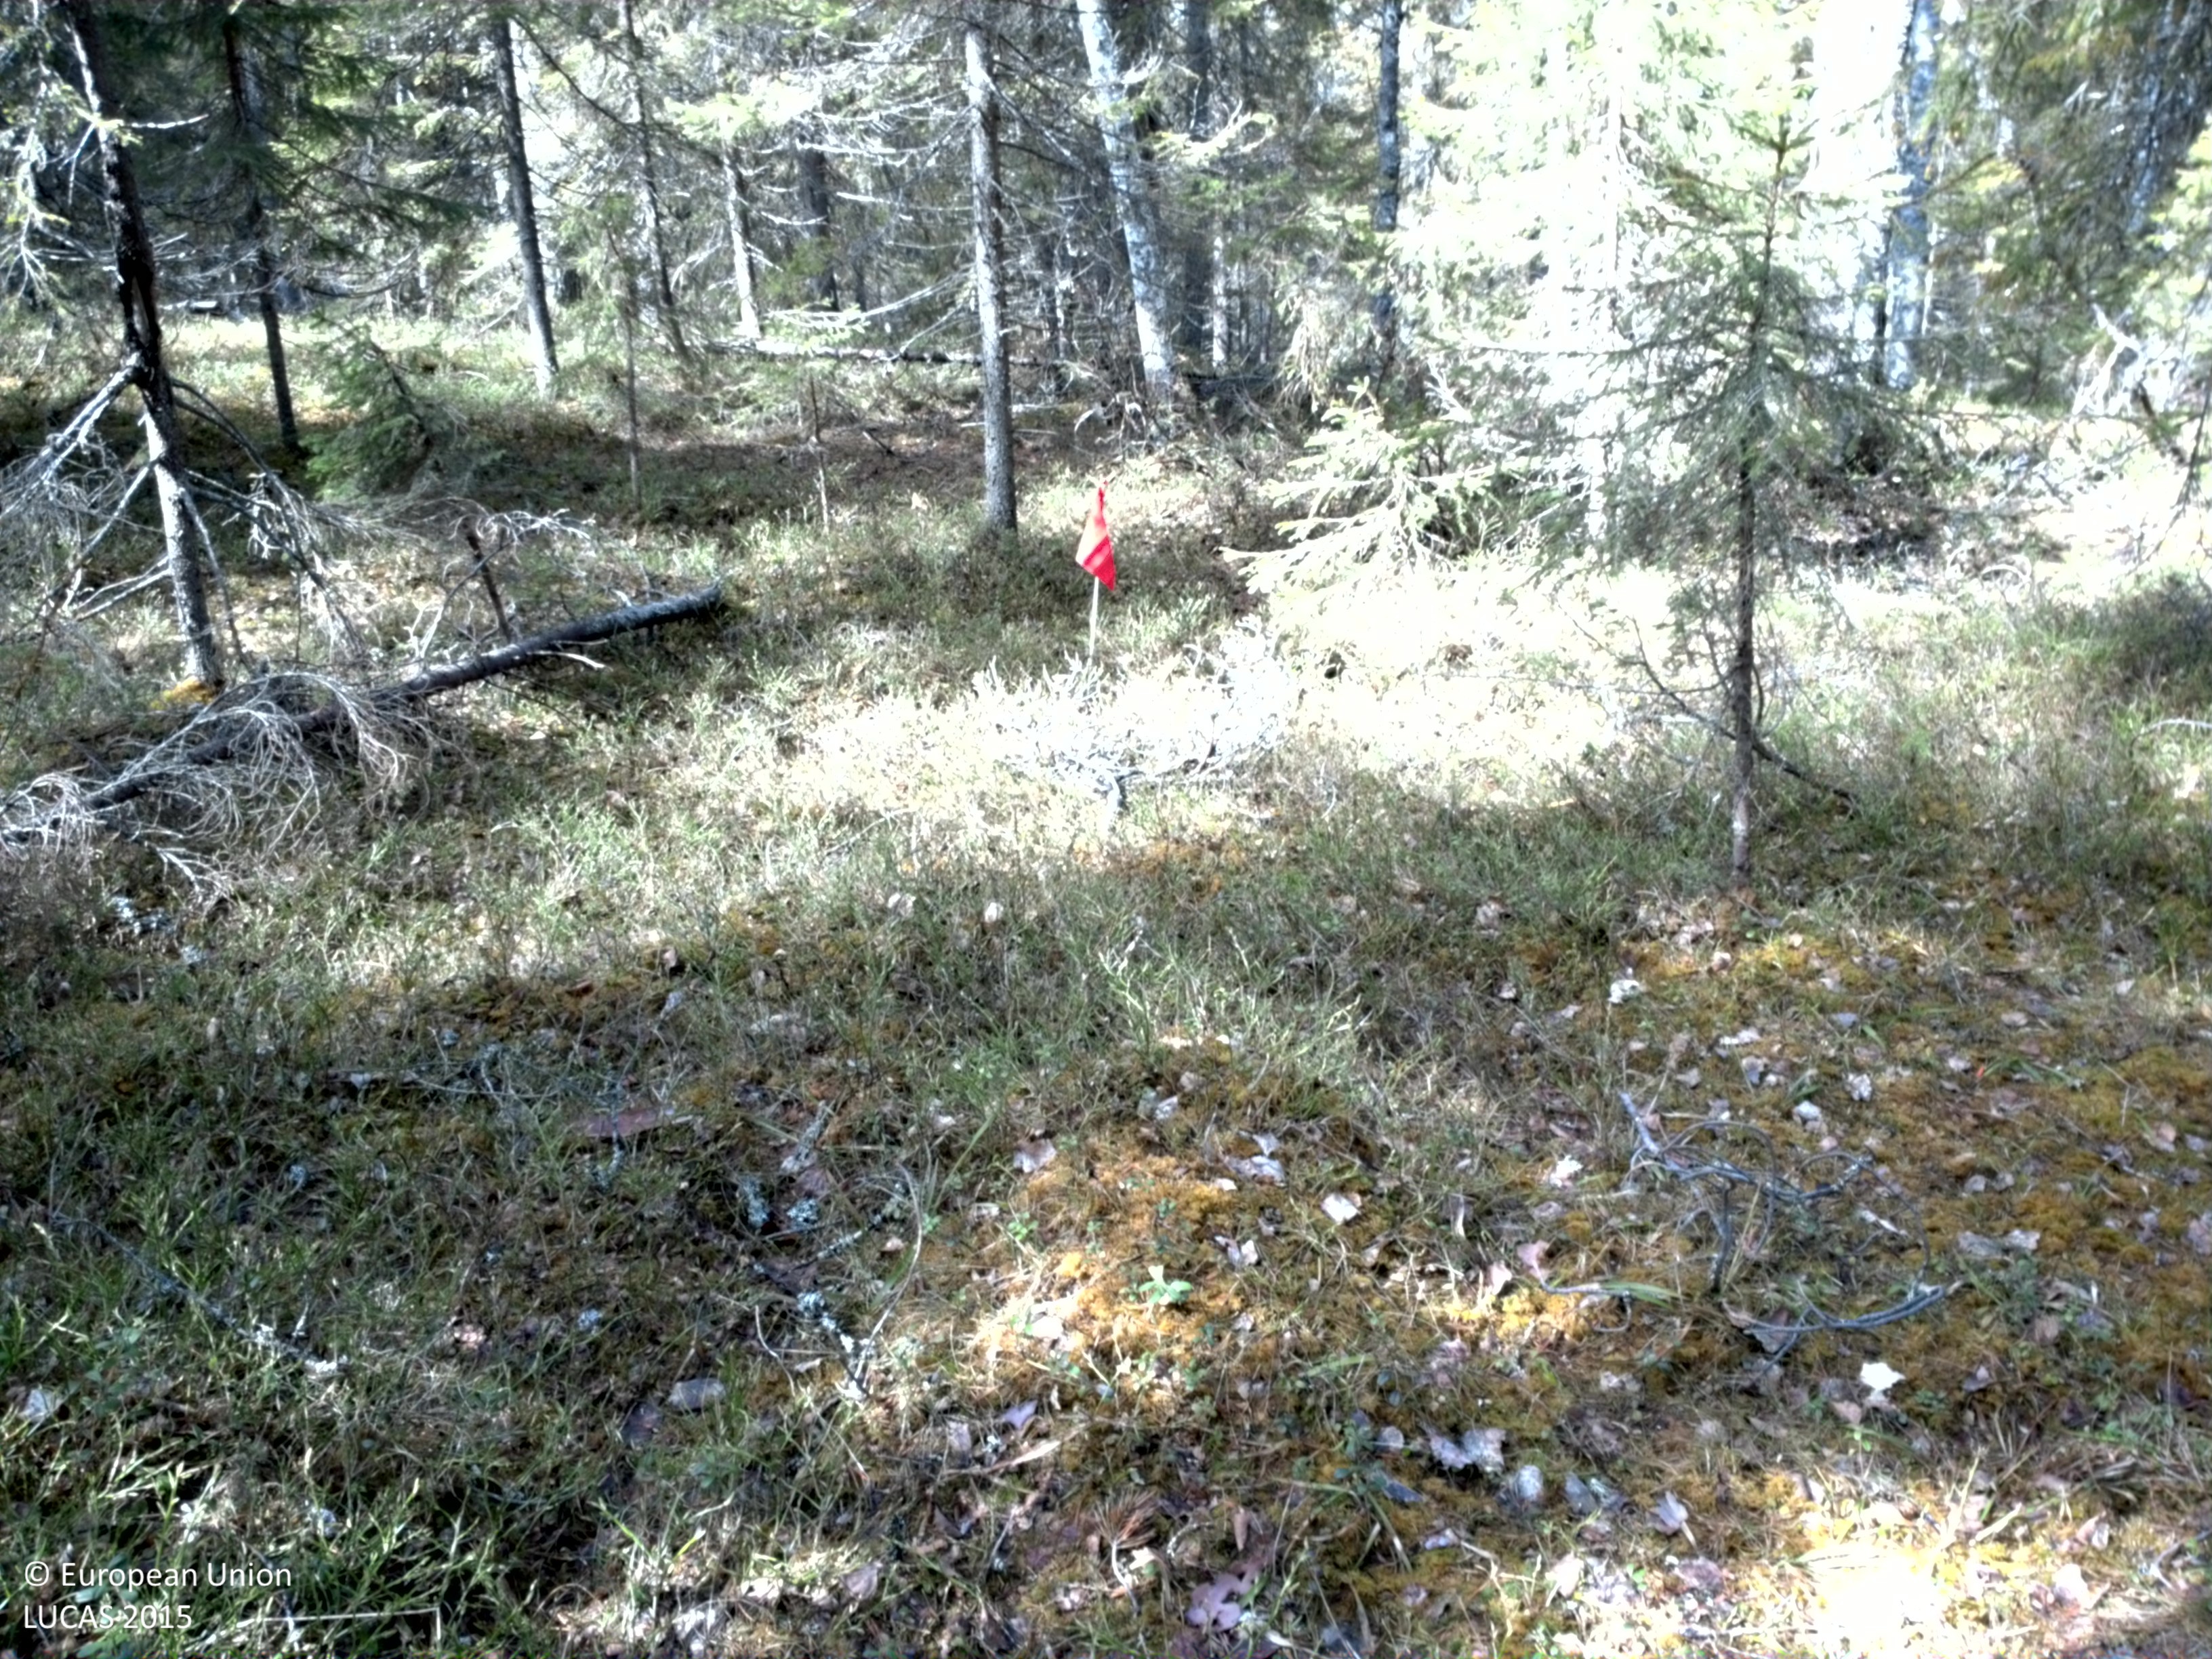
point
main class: Woodland
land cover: Spruce dominated coniferous woodland
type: boreal forest
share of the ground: > 75 %
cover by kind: coniferous forest trees 75 %, shrubs 15 %, broadleaved forest trees 10 %
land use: Forestry
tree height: > 5 m
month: June
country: SE
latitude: 66.4309
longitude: 23.2721
